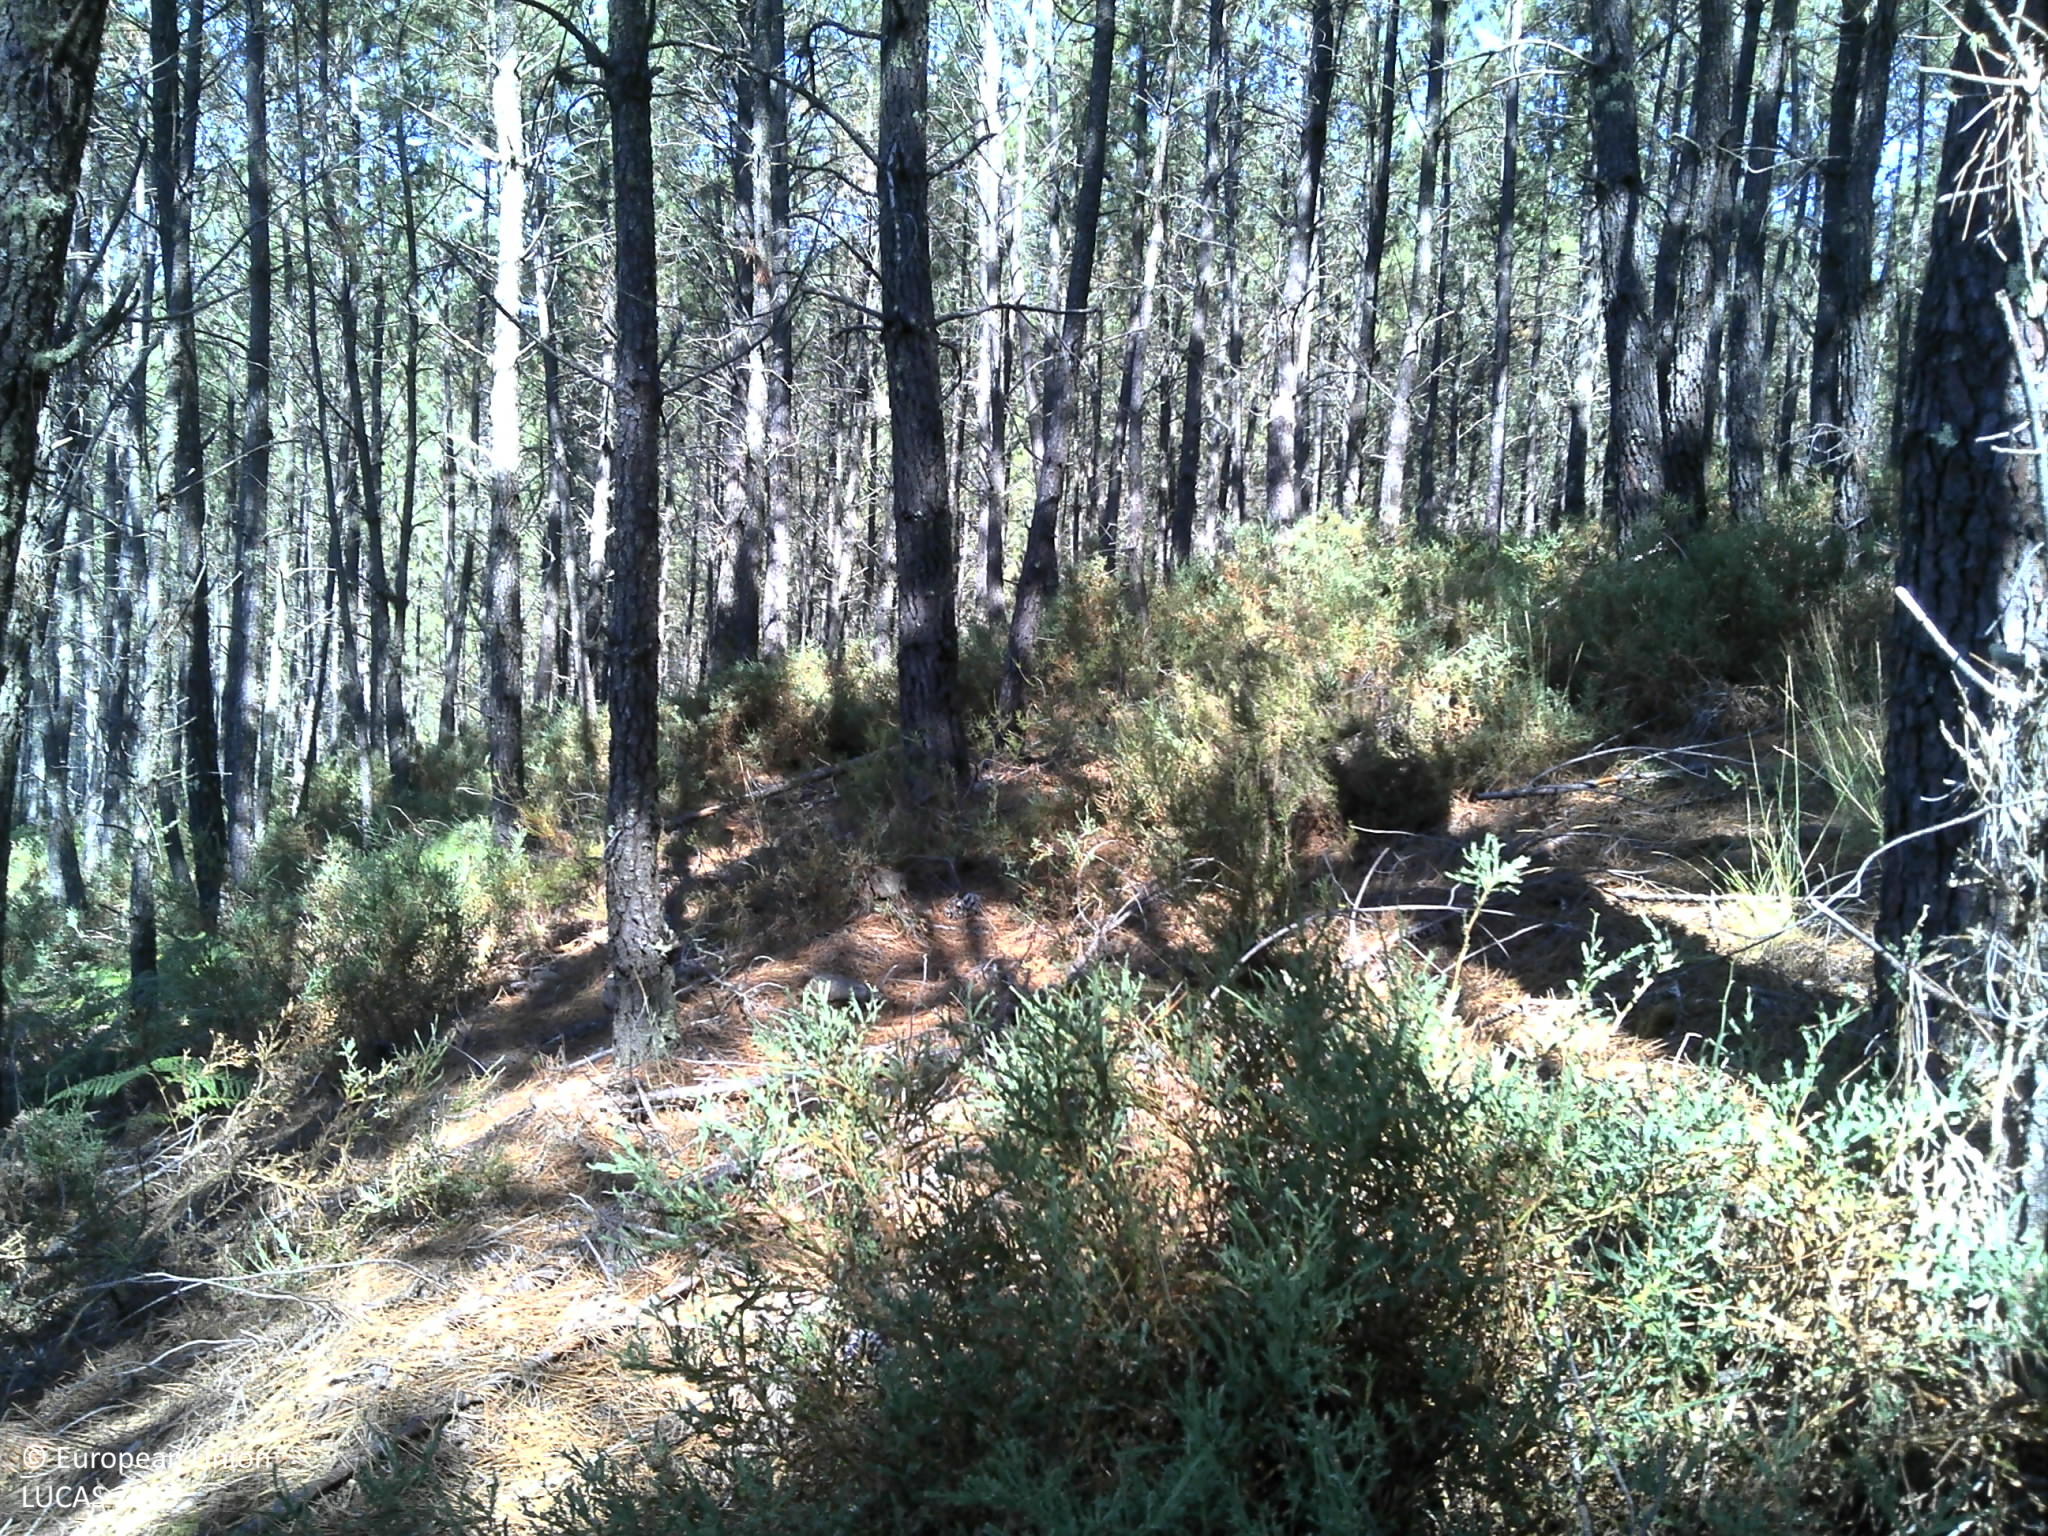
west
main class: Woodland
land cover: Pine dominated coniferous woodland
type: coniferous forest of the mediterranean region
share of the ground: 10 - 25 %
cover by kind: shrubs 60 %, coniferous forest trees 20 %, unconsolidated bare surface 20 %
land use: Forestry
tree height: > 5 m
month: July
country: PT
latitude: 40.7784
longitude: -7.8385
